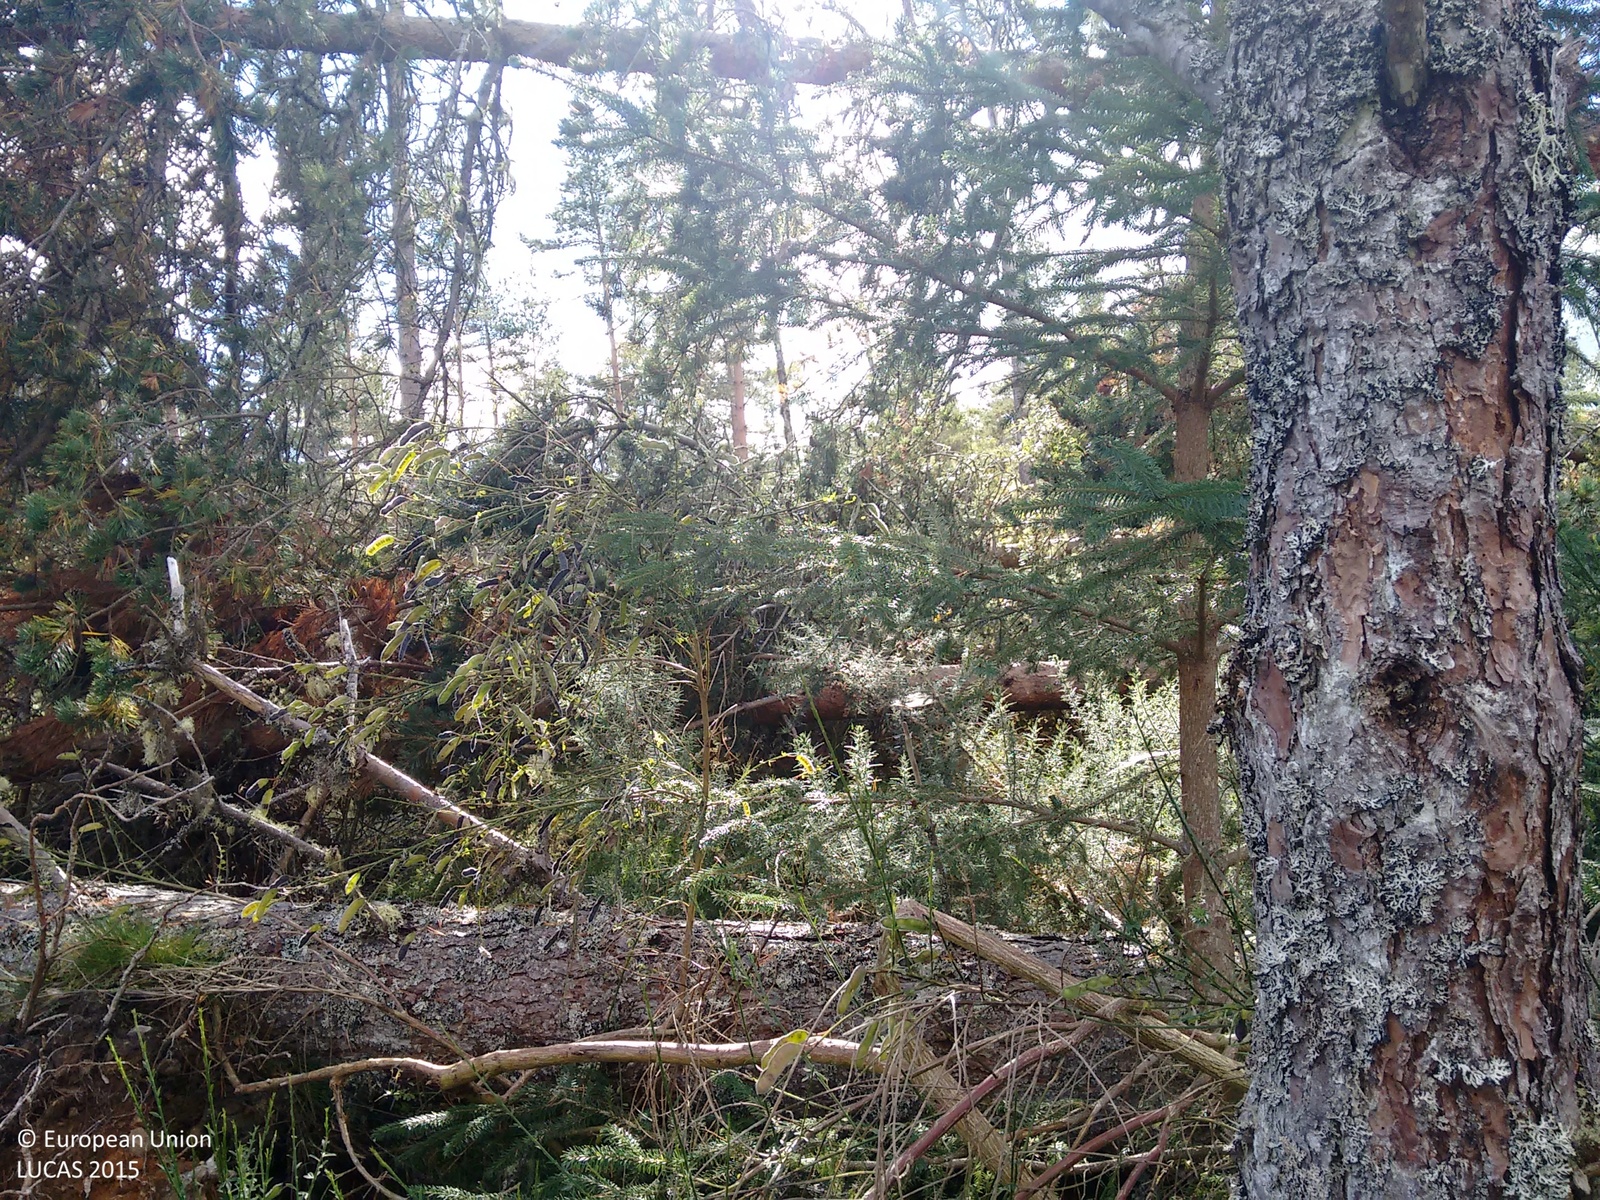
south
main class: Woodland
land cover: Broadleaved woodland
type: mesophytic deciduous forest
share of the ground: > 75 %
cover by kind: broadleaved forest trees 50 %, shrubs 20 %, lichens and mosses 10 %, unconsolidated bare surface 10 %, coniferous forest trees 5 %, herbaceous plants 5 %
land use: Forestry
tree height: < 5 m
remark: Clear cut
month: September
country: GB
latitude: 57.4062
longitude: -4.5229
